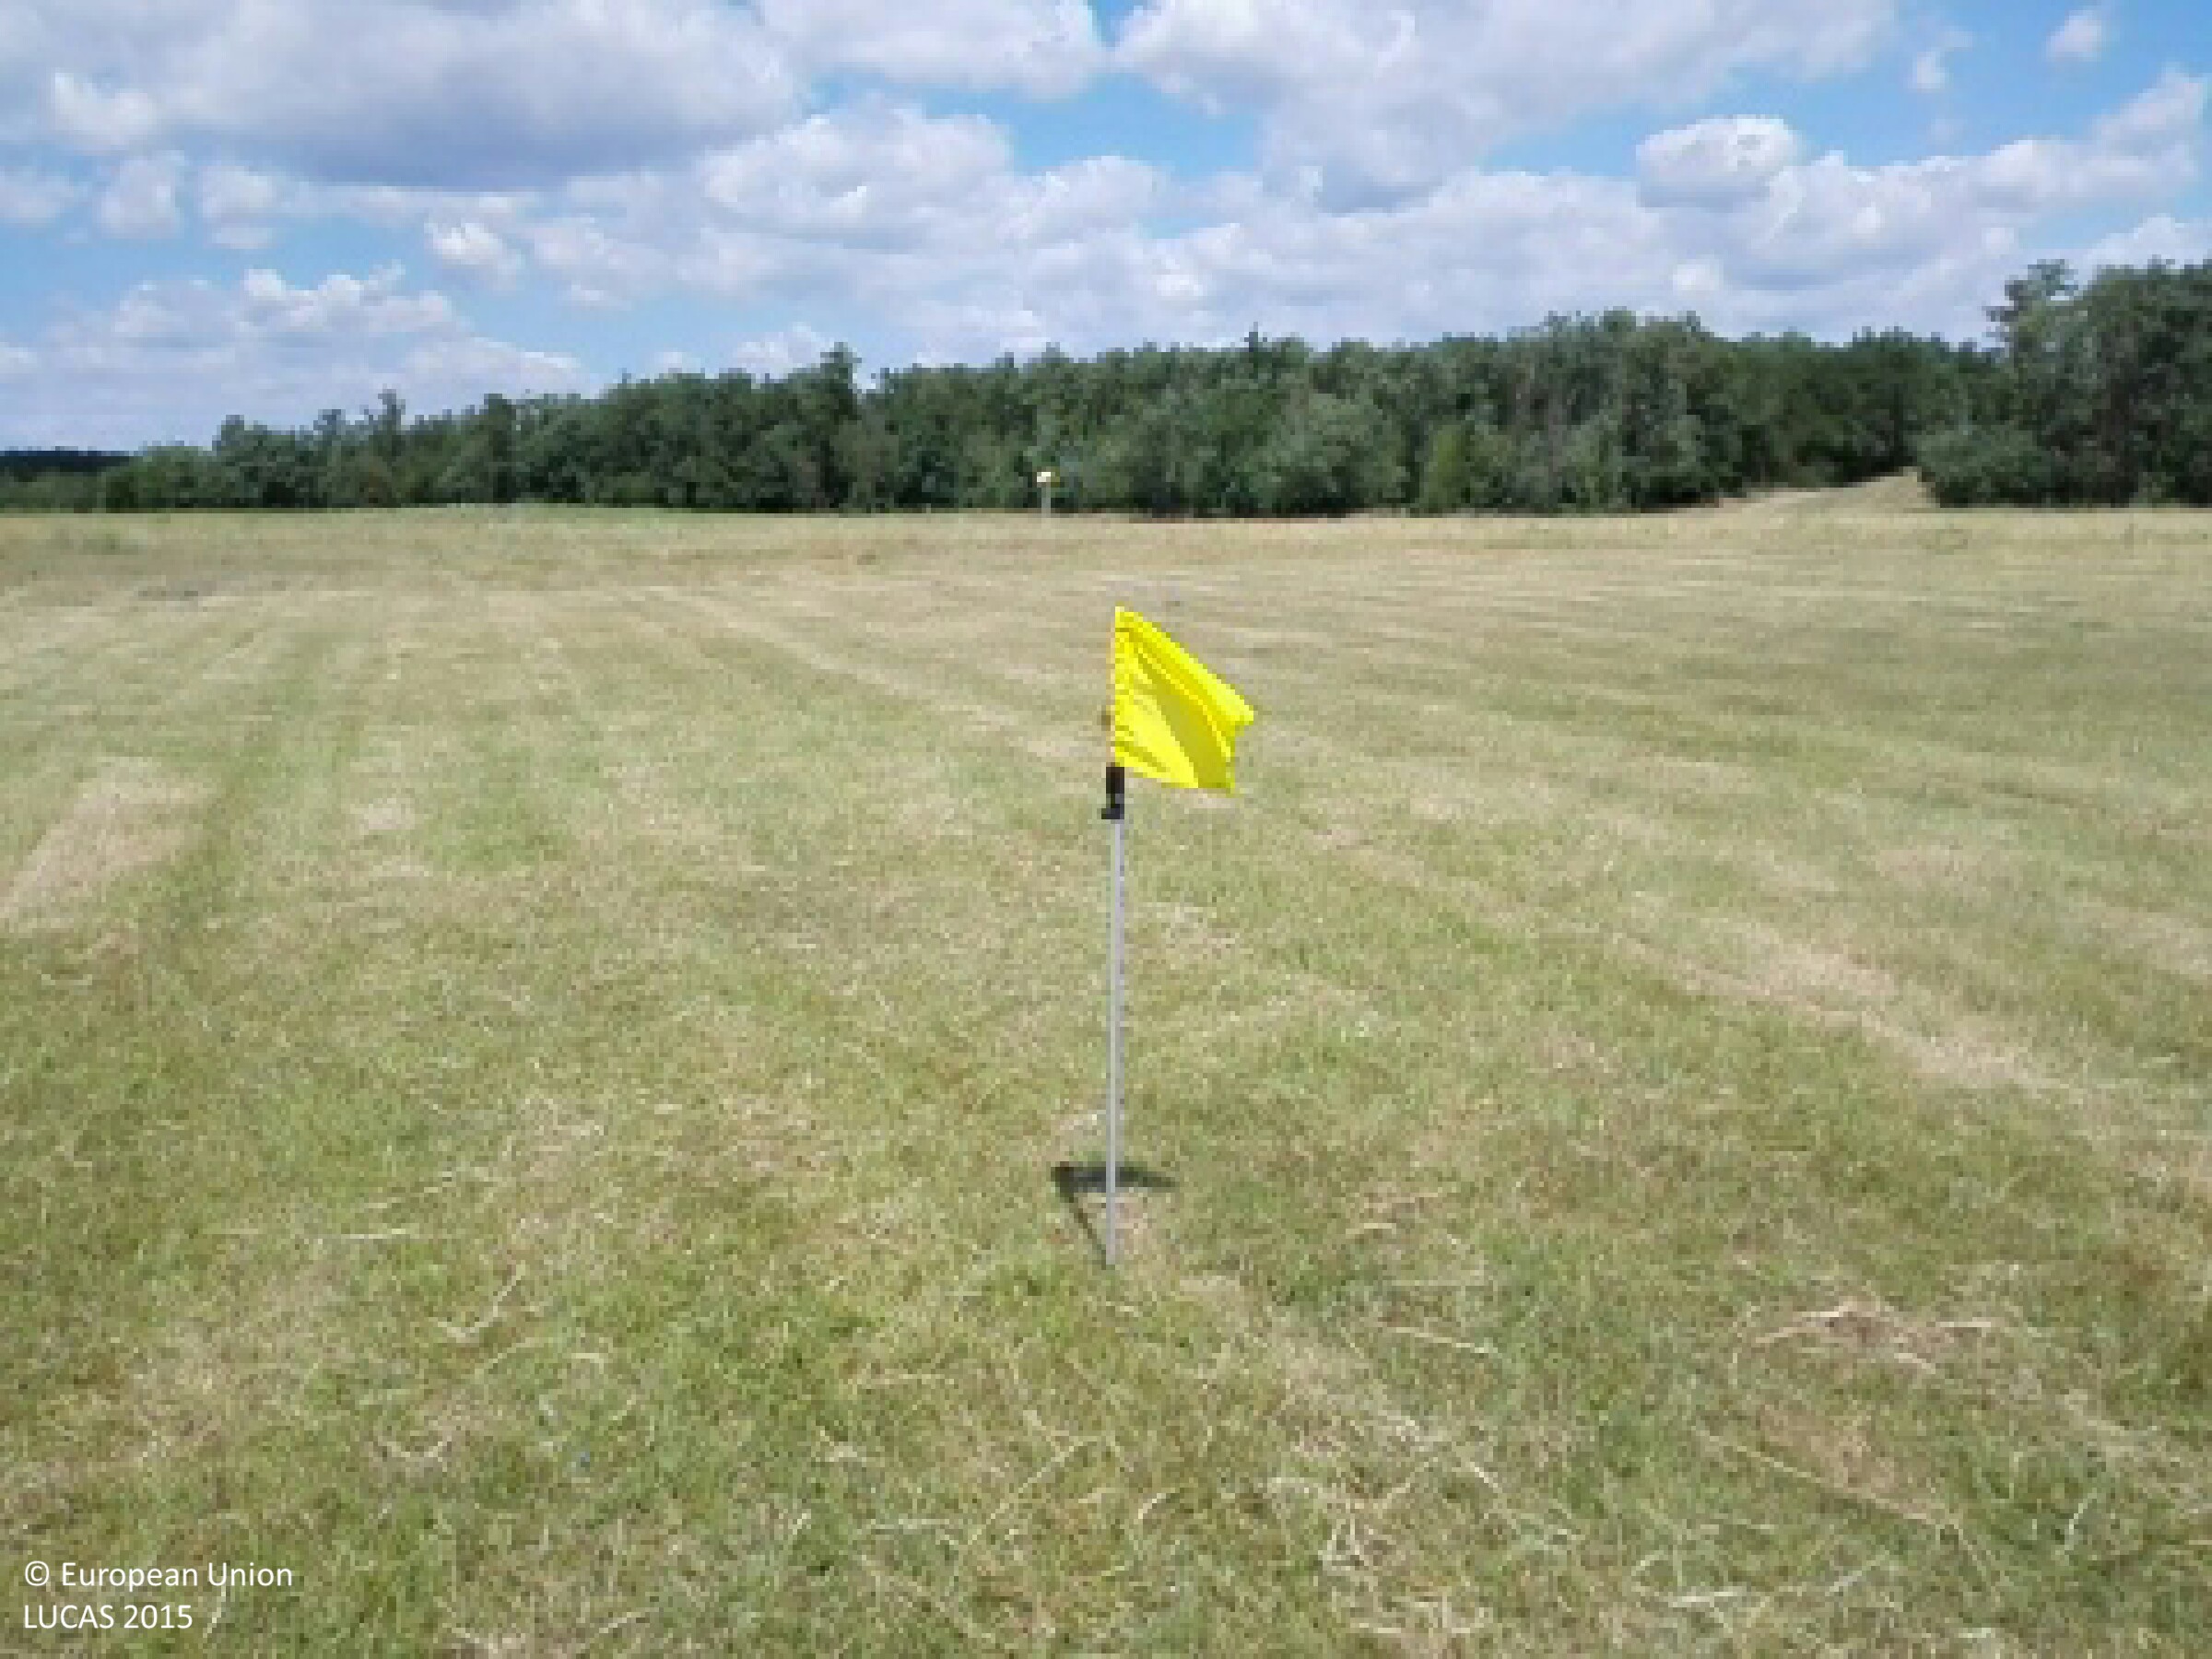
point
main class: Grassland
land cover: Grassland without tree/shrub cover
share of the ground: > 75 %
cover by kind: herbaceous plants 100 %
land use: Agriculture (excluding fallow land and kitchen gardens)
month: July
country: HU
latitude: 47.6886
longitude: 21.7039
